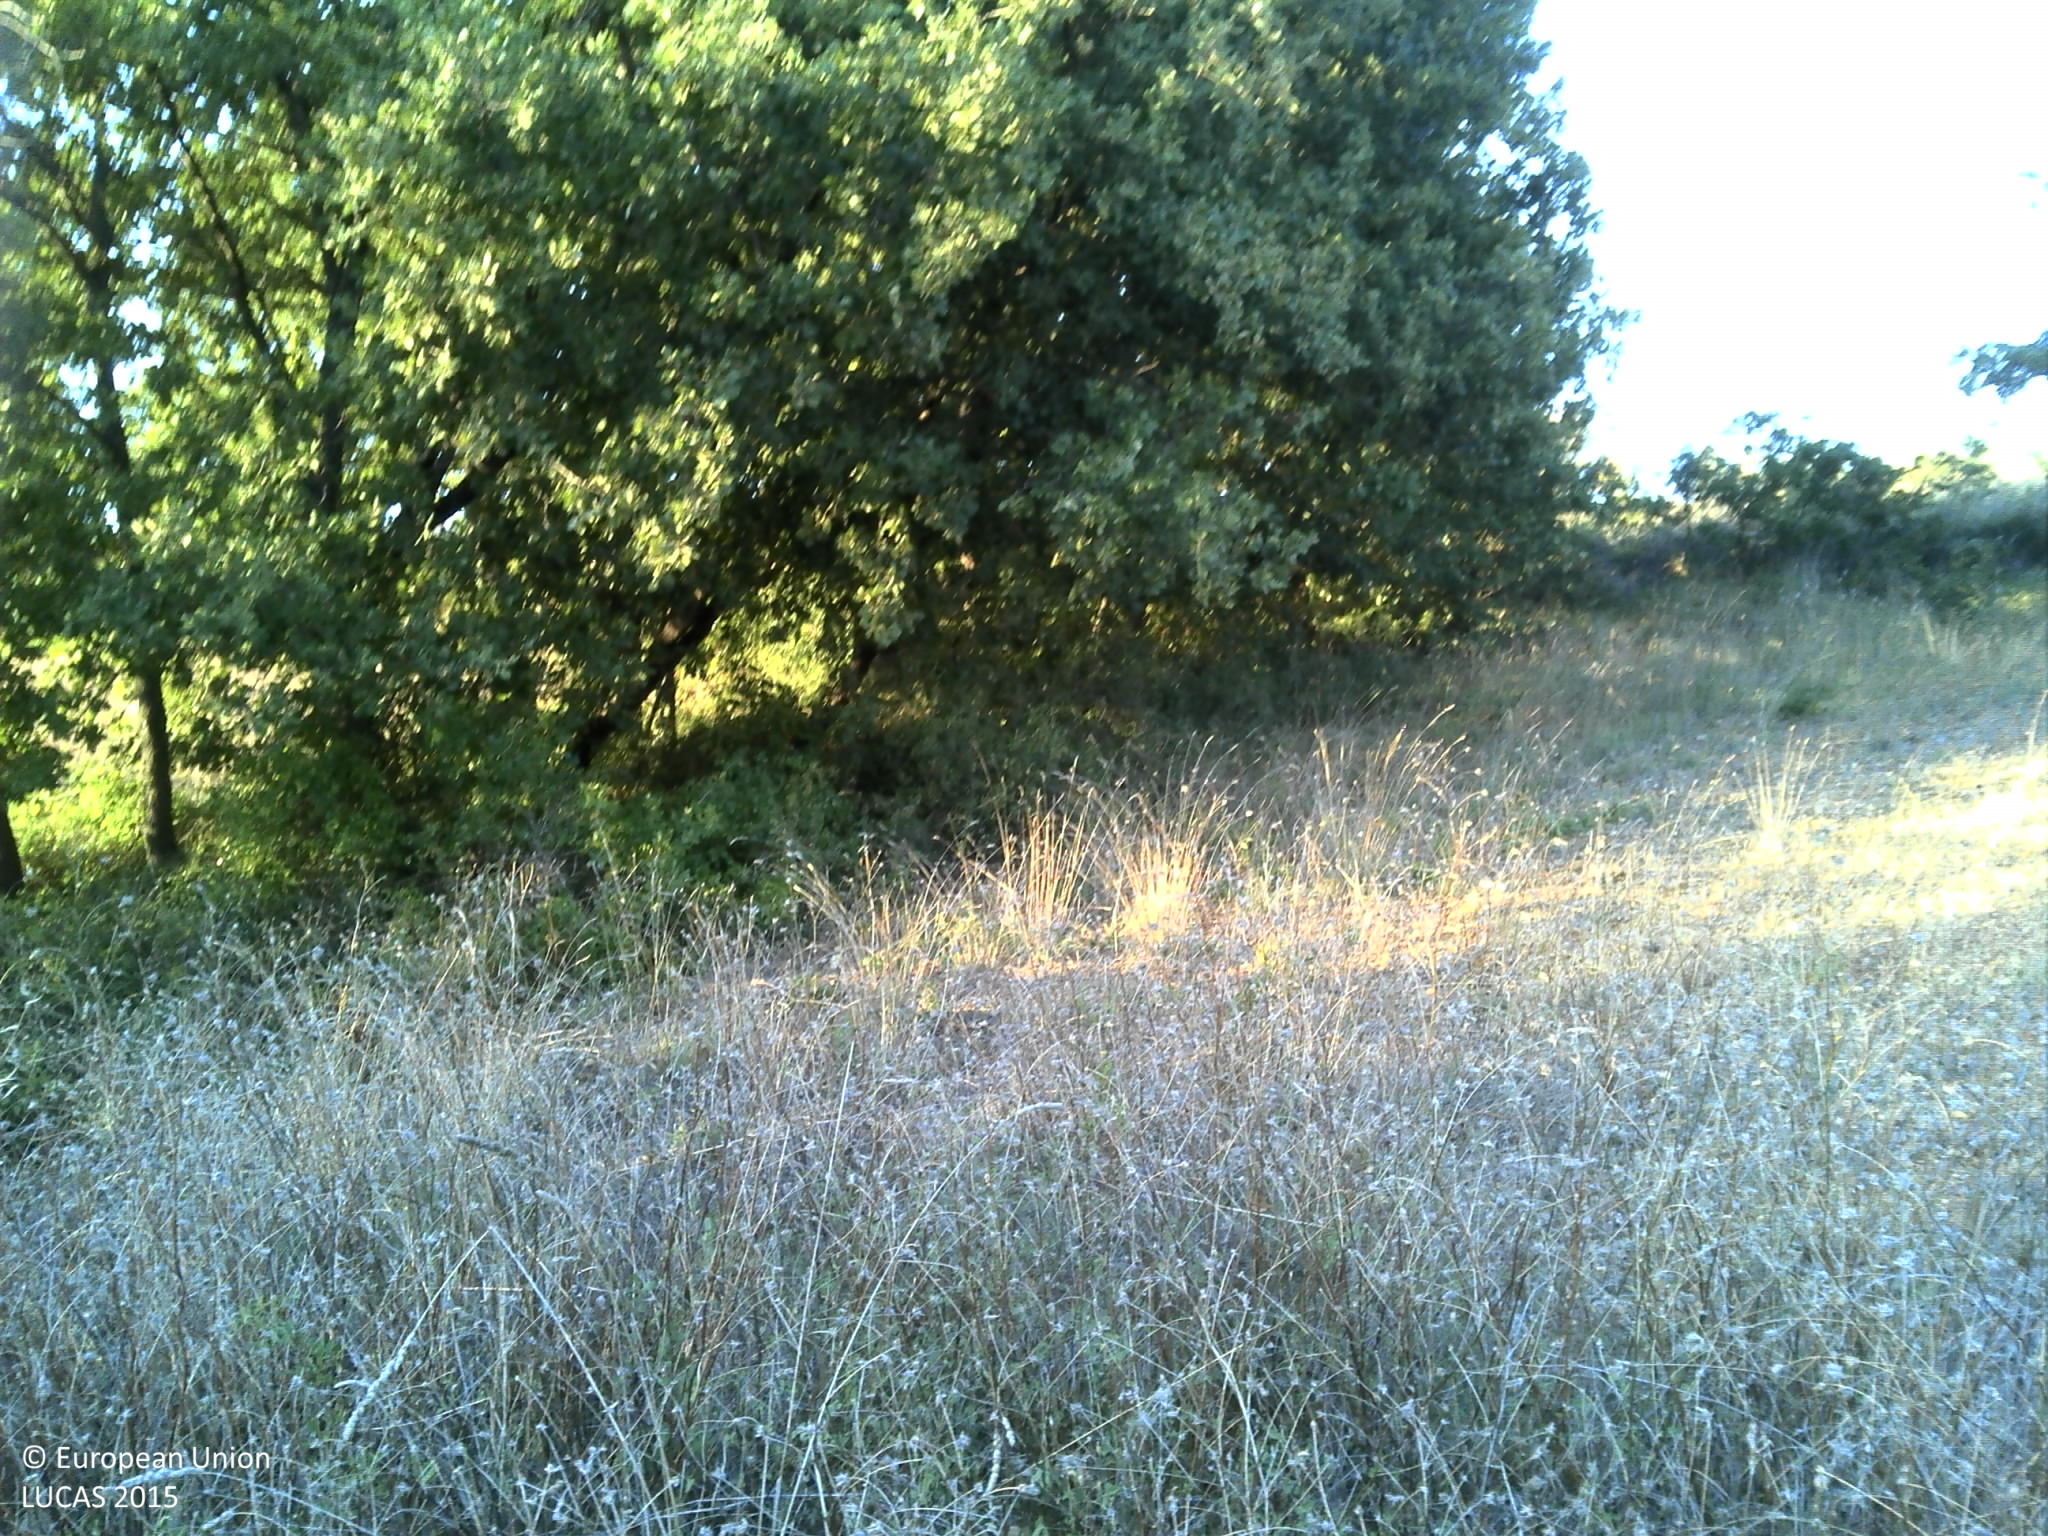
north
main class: Grassland
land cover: Spontaneously vegetated surfaces
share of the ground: > 75 %
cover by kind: herbaceous plants 95 %, shrubs 5 %
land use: Abandoned areas
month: October
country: FR
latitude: 43.5080
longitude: 3.4163
